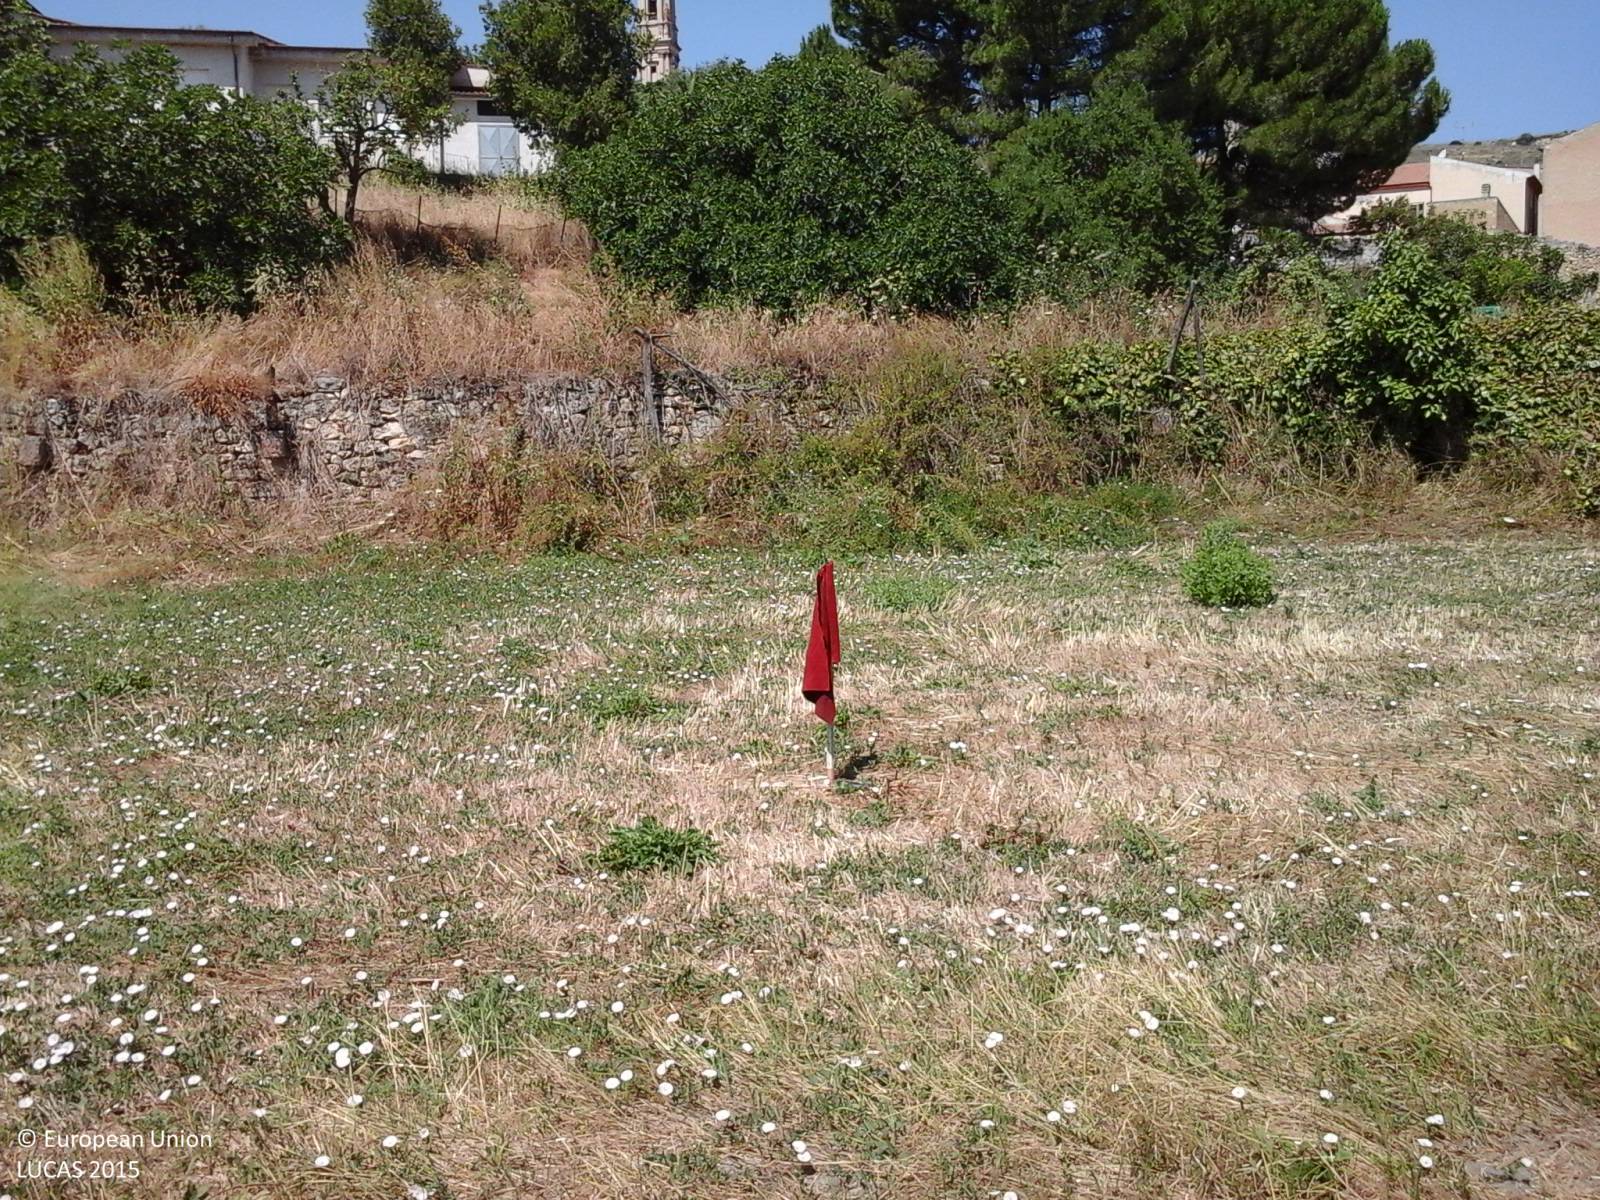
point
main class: Grassland
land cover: Grassland without tree/shrub cover
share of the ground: > 75 %
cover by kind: herbaceous plants 100 %
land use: Agriculture (excluding fallow land and kitchen gardens)
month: July
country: IT
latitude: 40.5501
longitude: 8.8368
